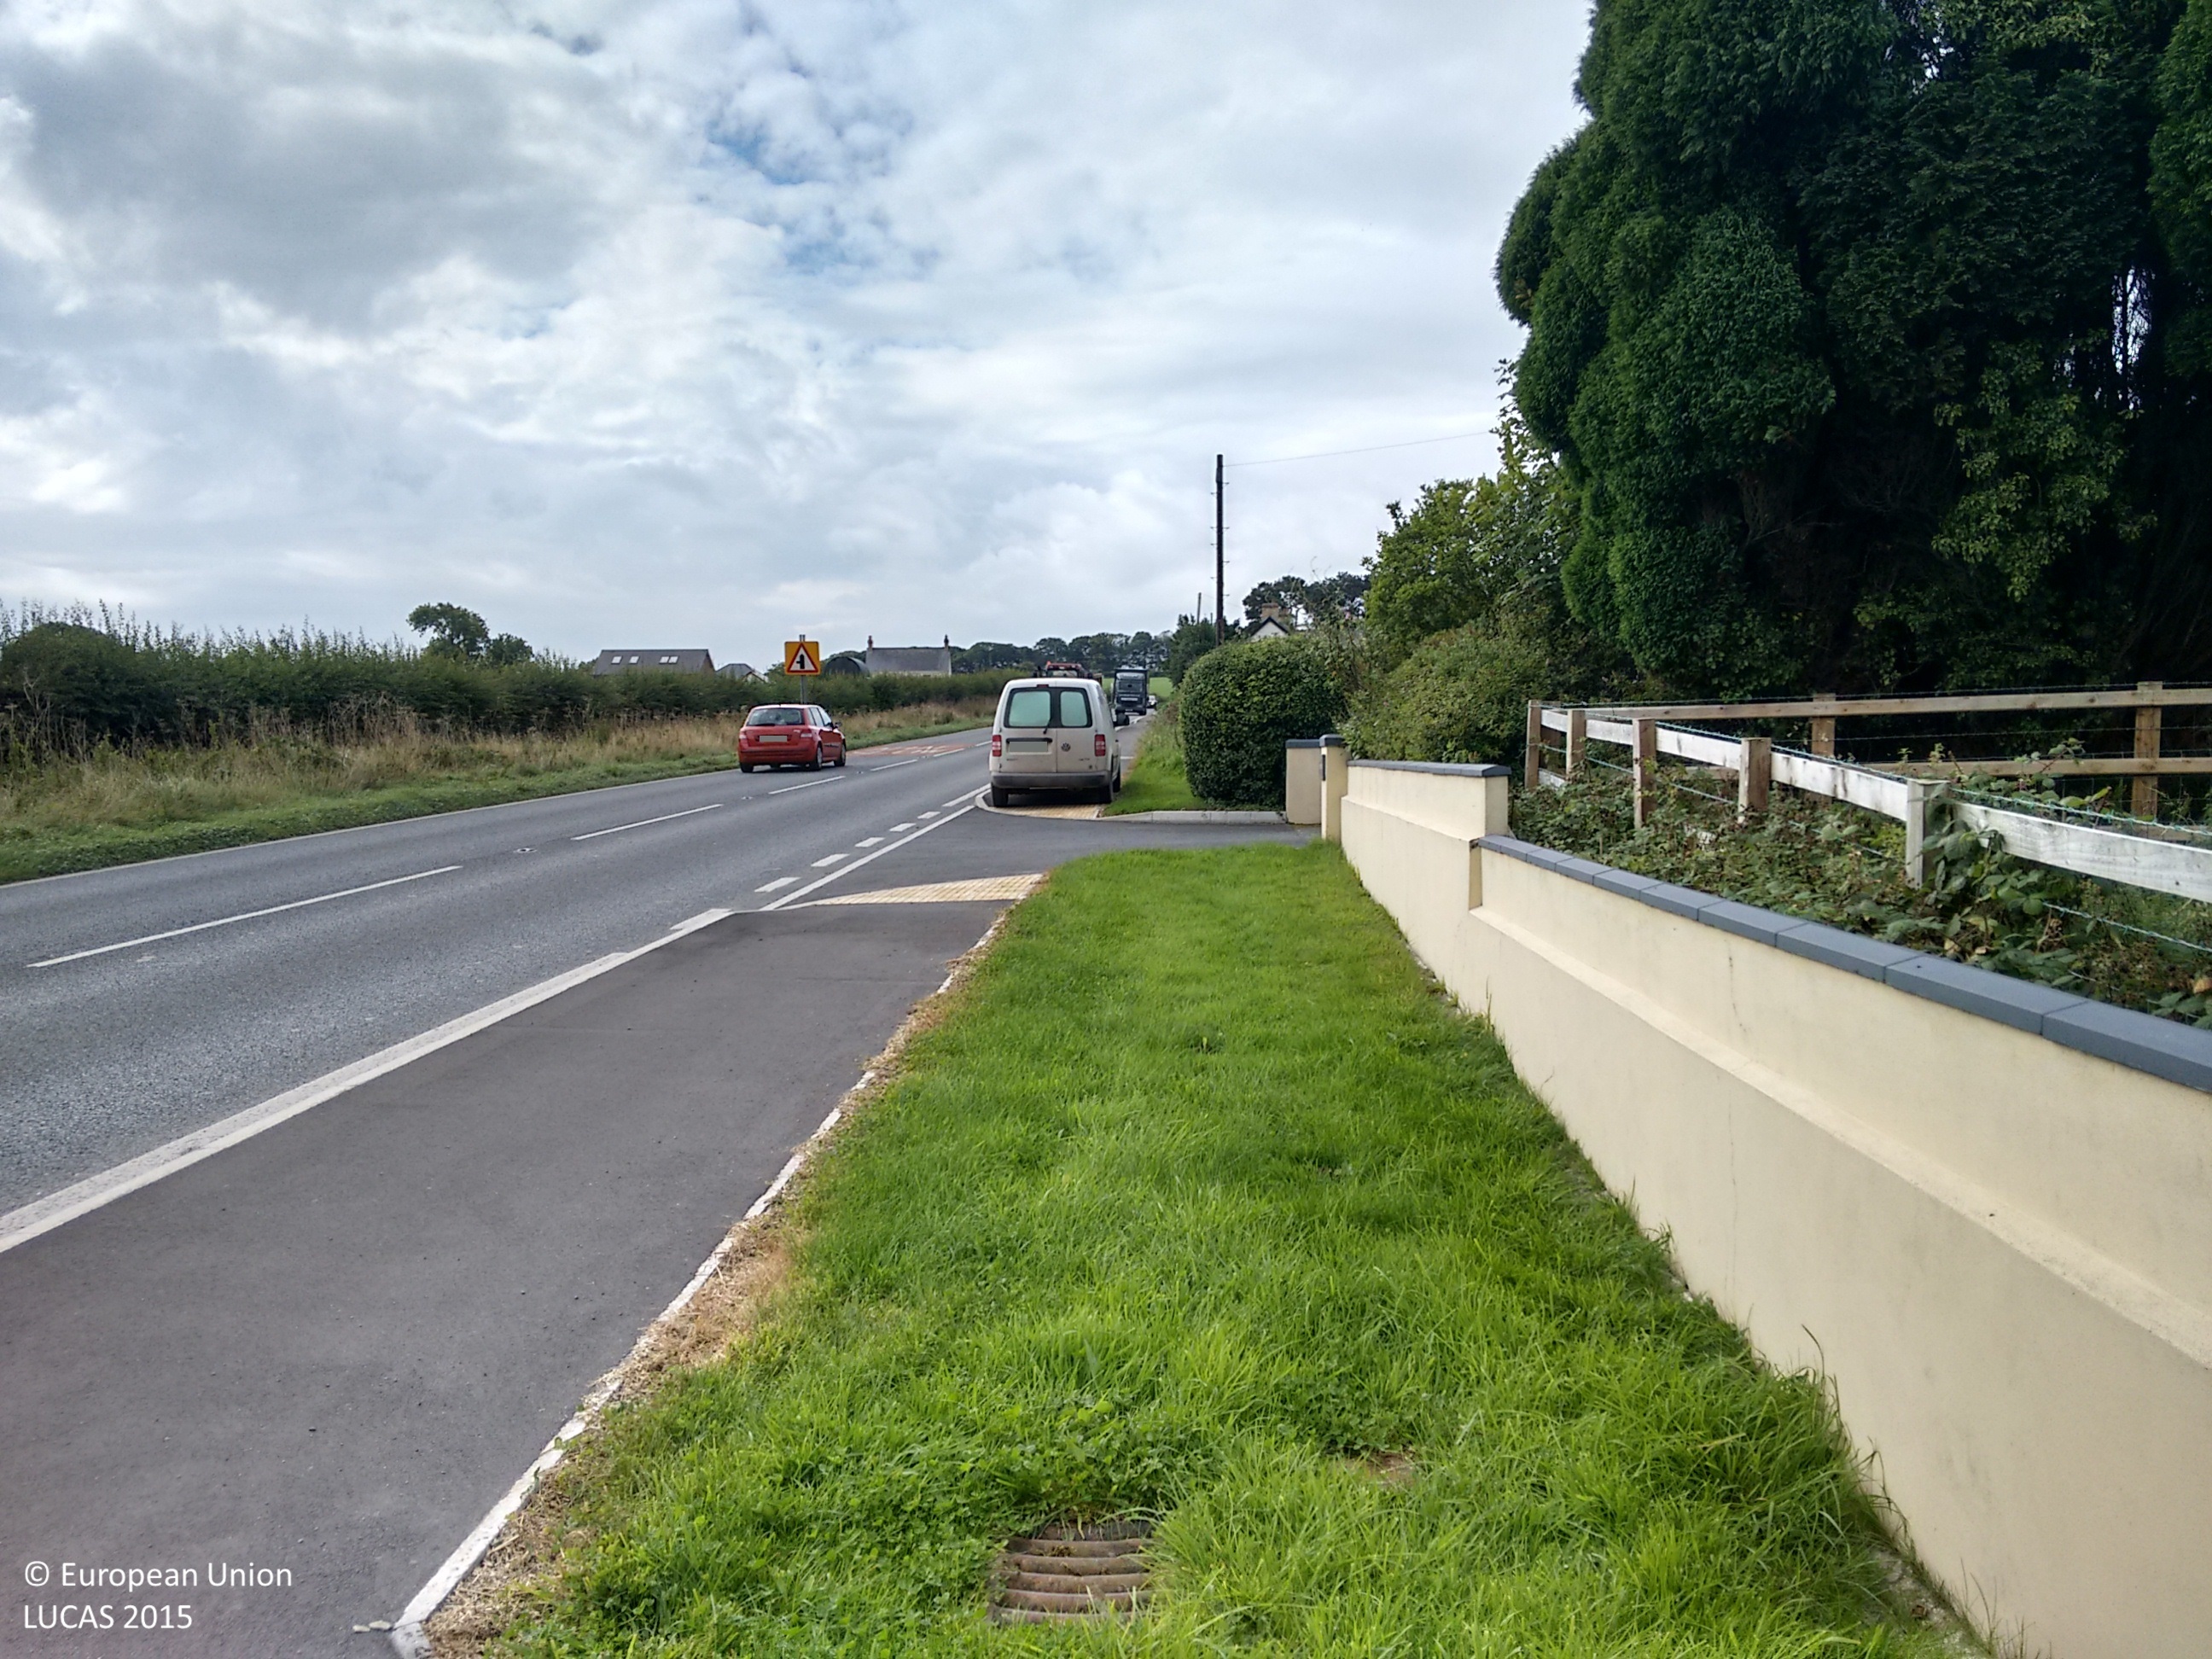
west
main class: Grassland
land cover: Grassland without tree/shrub cover
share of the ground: > 75 %
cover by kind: herbaceous plants 100 %
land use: Agriculture (excluding fallow land and kitchen gardens)
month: September
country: GB
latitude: 52.1108
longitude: -4.5778
